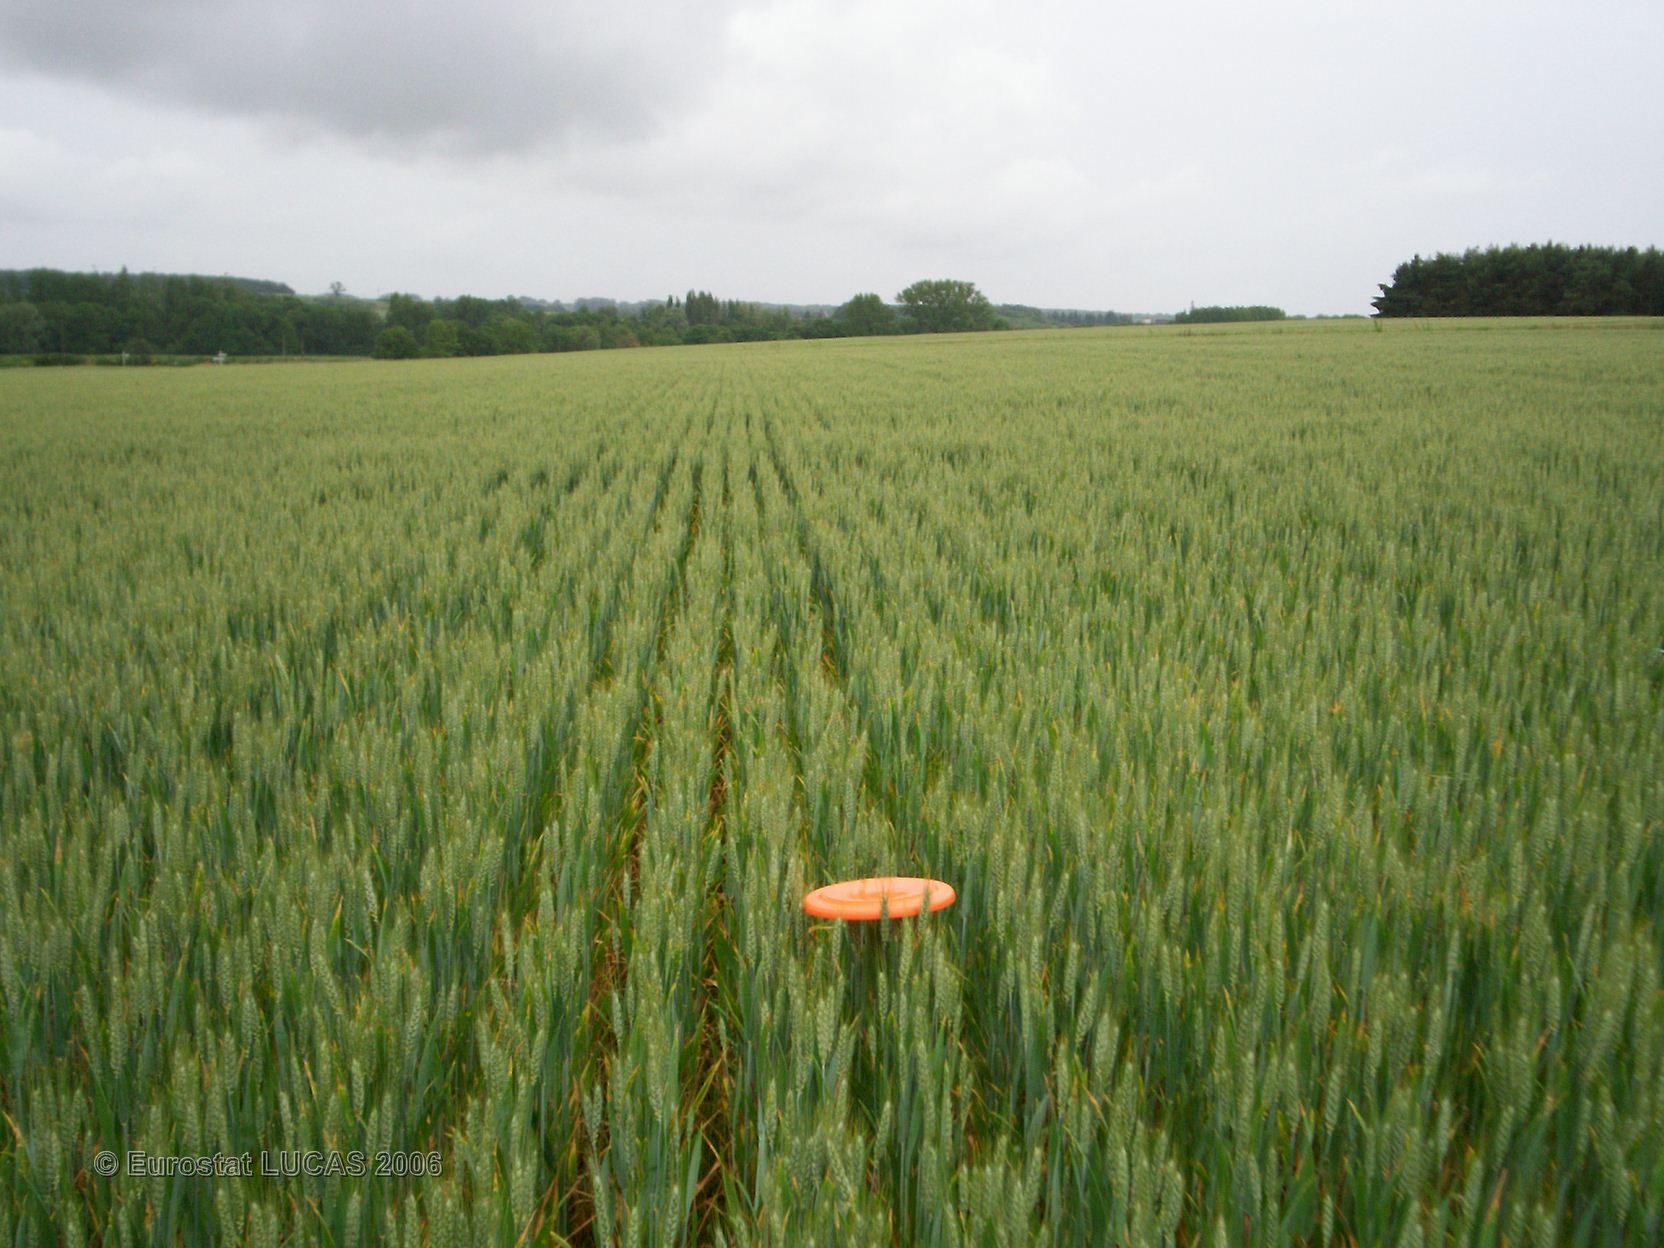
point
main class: Cropland
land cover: Common wheat
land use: Agriculture (excluding fallow land and kitchen gardens)
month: May
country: FR
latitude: 47.5215
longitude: 0.9112
